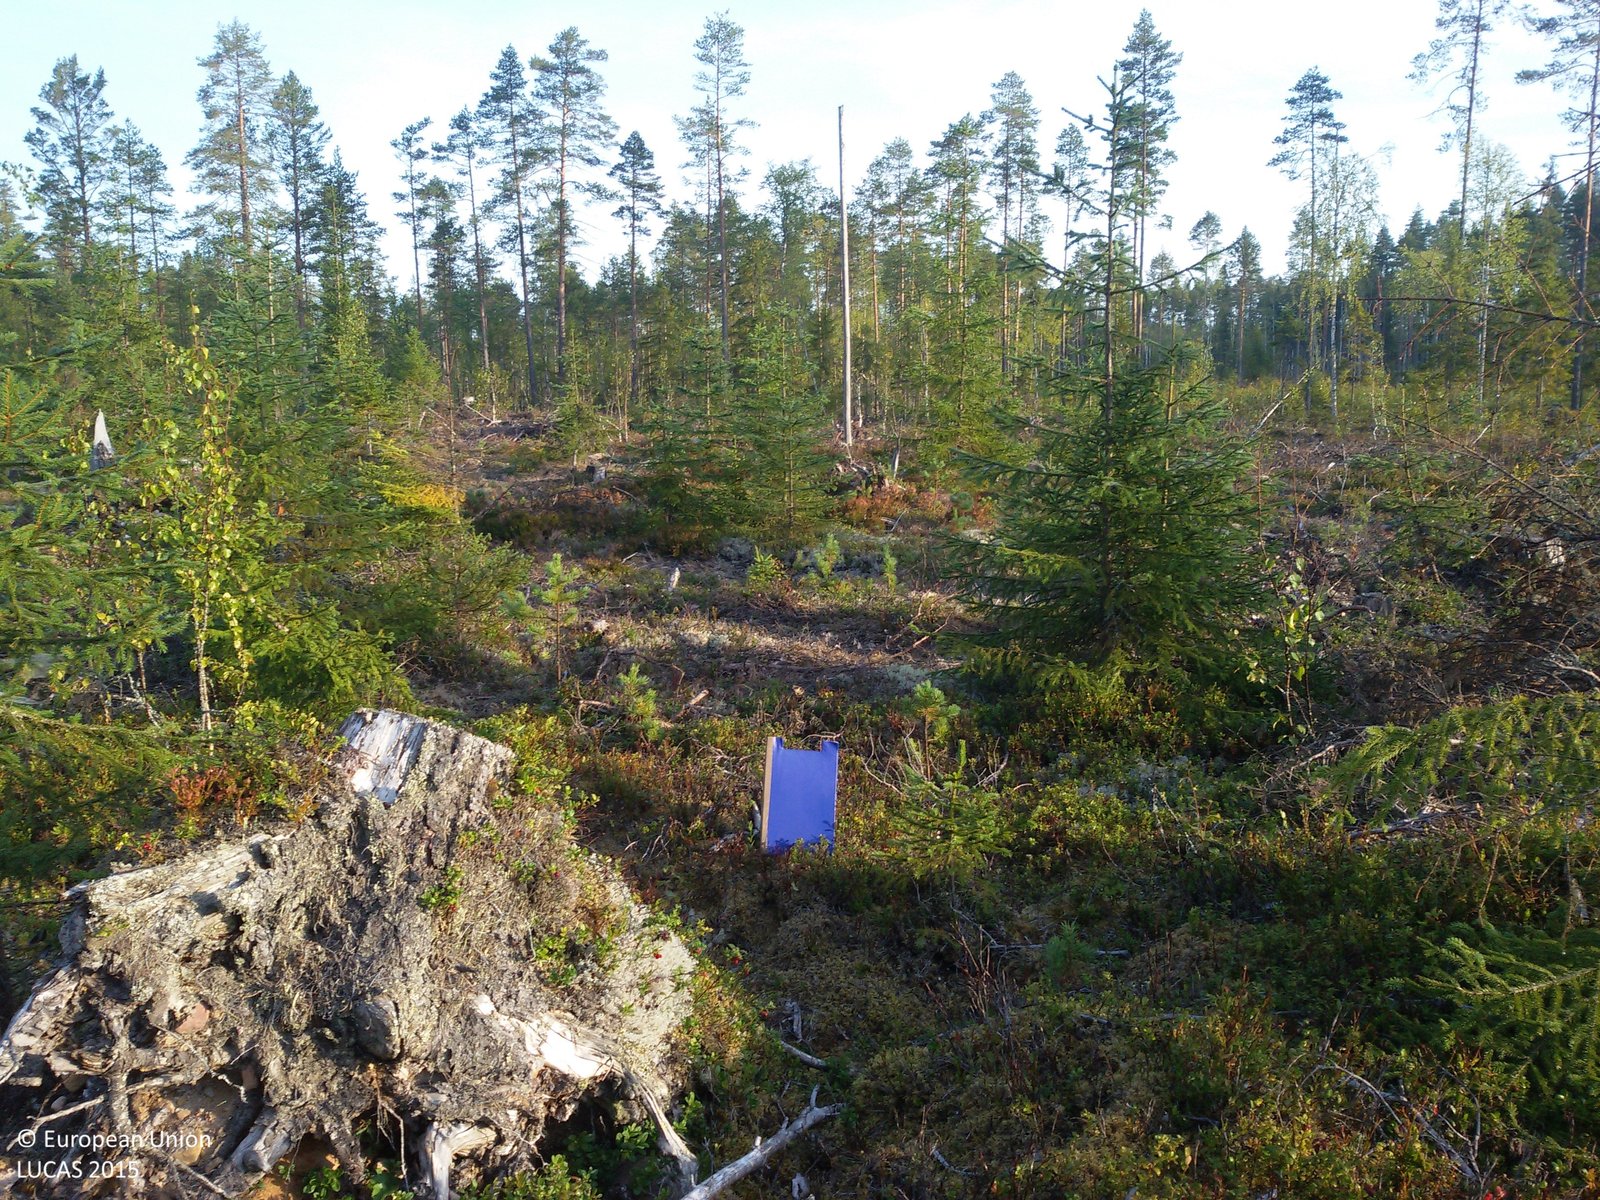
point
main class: Woodland
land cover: Spruce dominated coniferous woodland
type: boreal forest
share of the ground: 25 - 50 %
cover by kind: herbaceous plants 40 %, lichens and mosses 30 %, coniferous forest trees 25 %, broadleaved forest trees 5 %
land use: Forestry
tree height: < 5 m
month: September
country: SE
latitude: 61.0112
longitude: 15.0358
